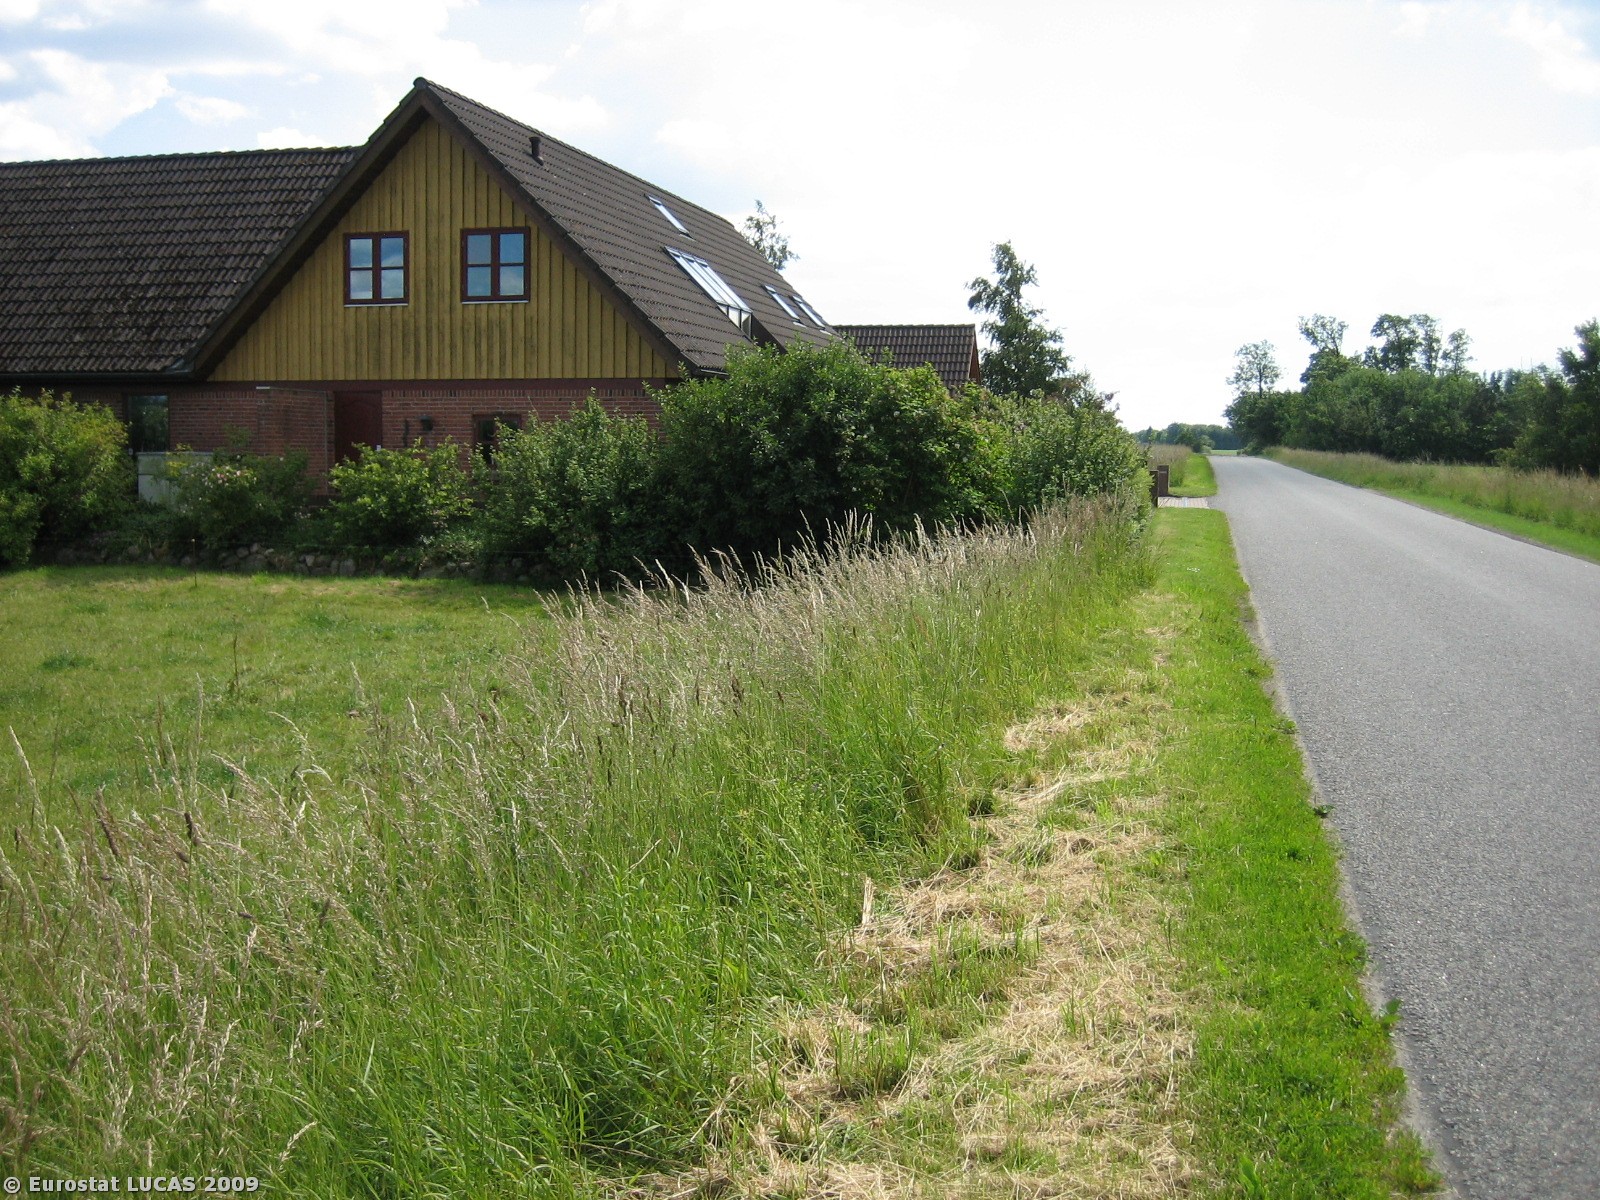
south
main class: Woodland
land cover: Broadleaved woodland
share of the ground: > 75 %
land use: Forestry
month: June
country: DK
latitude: 55.5381
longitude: 9.1926
